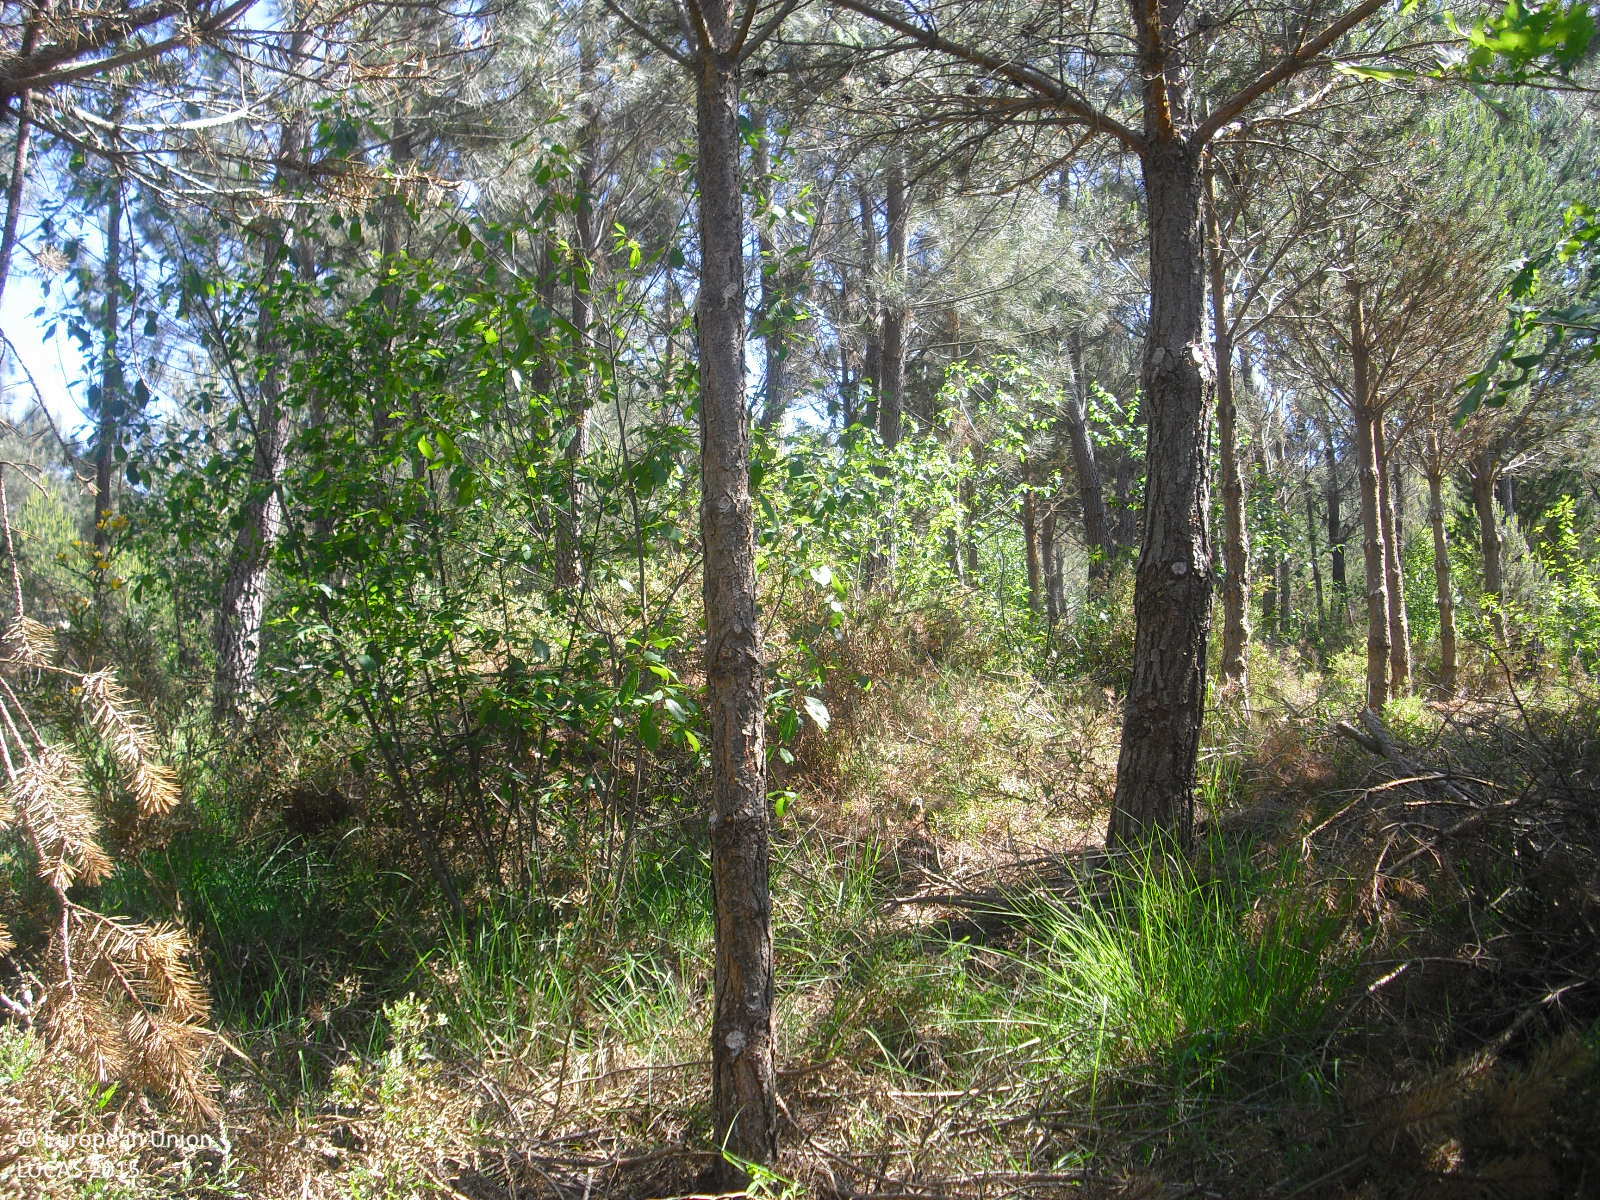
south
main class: Woodland
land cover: Pine dominated coniferous woodland
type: hemiboreal forest and nemoral coniferous forest and mixed broadleaved-coniferous forest
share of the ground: > 75 %
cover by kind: coniferous forest trees 80 %, shrubs 15 %, broadleaved forest trees 5 %
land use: Forestry
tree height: > 5 m
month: May
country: ES
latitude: 42.2368
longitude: -7.6279
